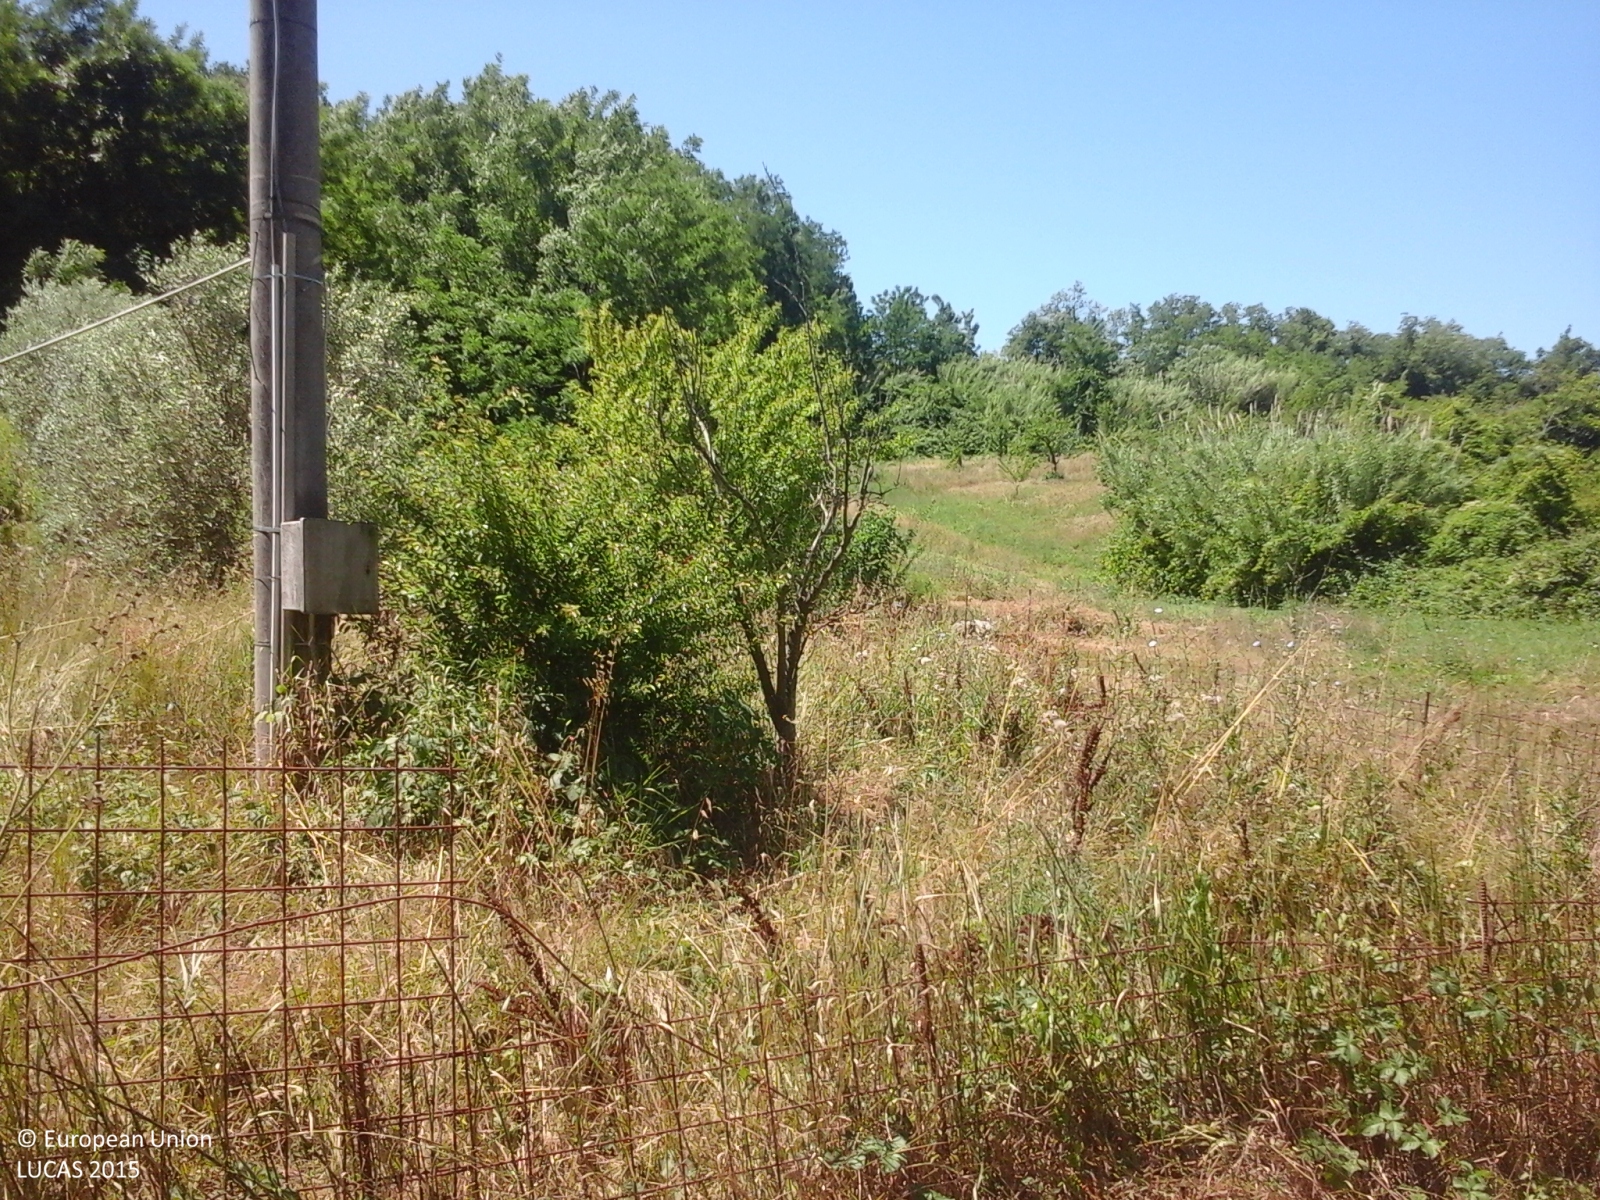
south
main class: Cropland
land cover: Olive groves
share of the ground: 50 - 75 %
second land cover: Grassland without tree/shrub cover
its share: 50 - 75 %
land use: Agriculture (excluding fallow land and kitchen gardens)
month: June
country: IT
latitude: 43.5730
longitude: 10.6051
